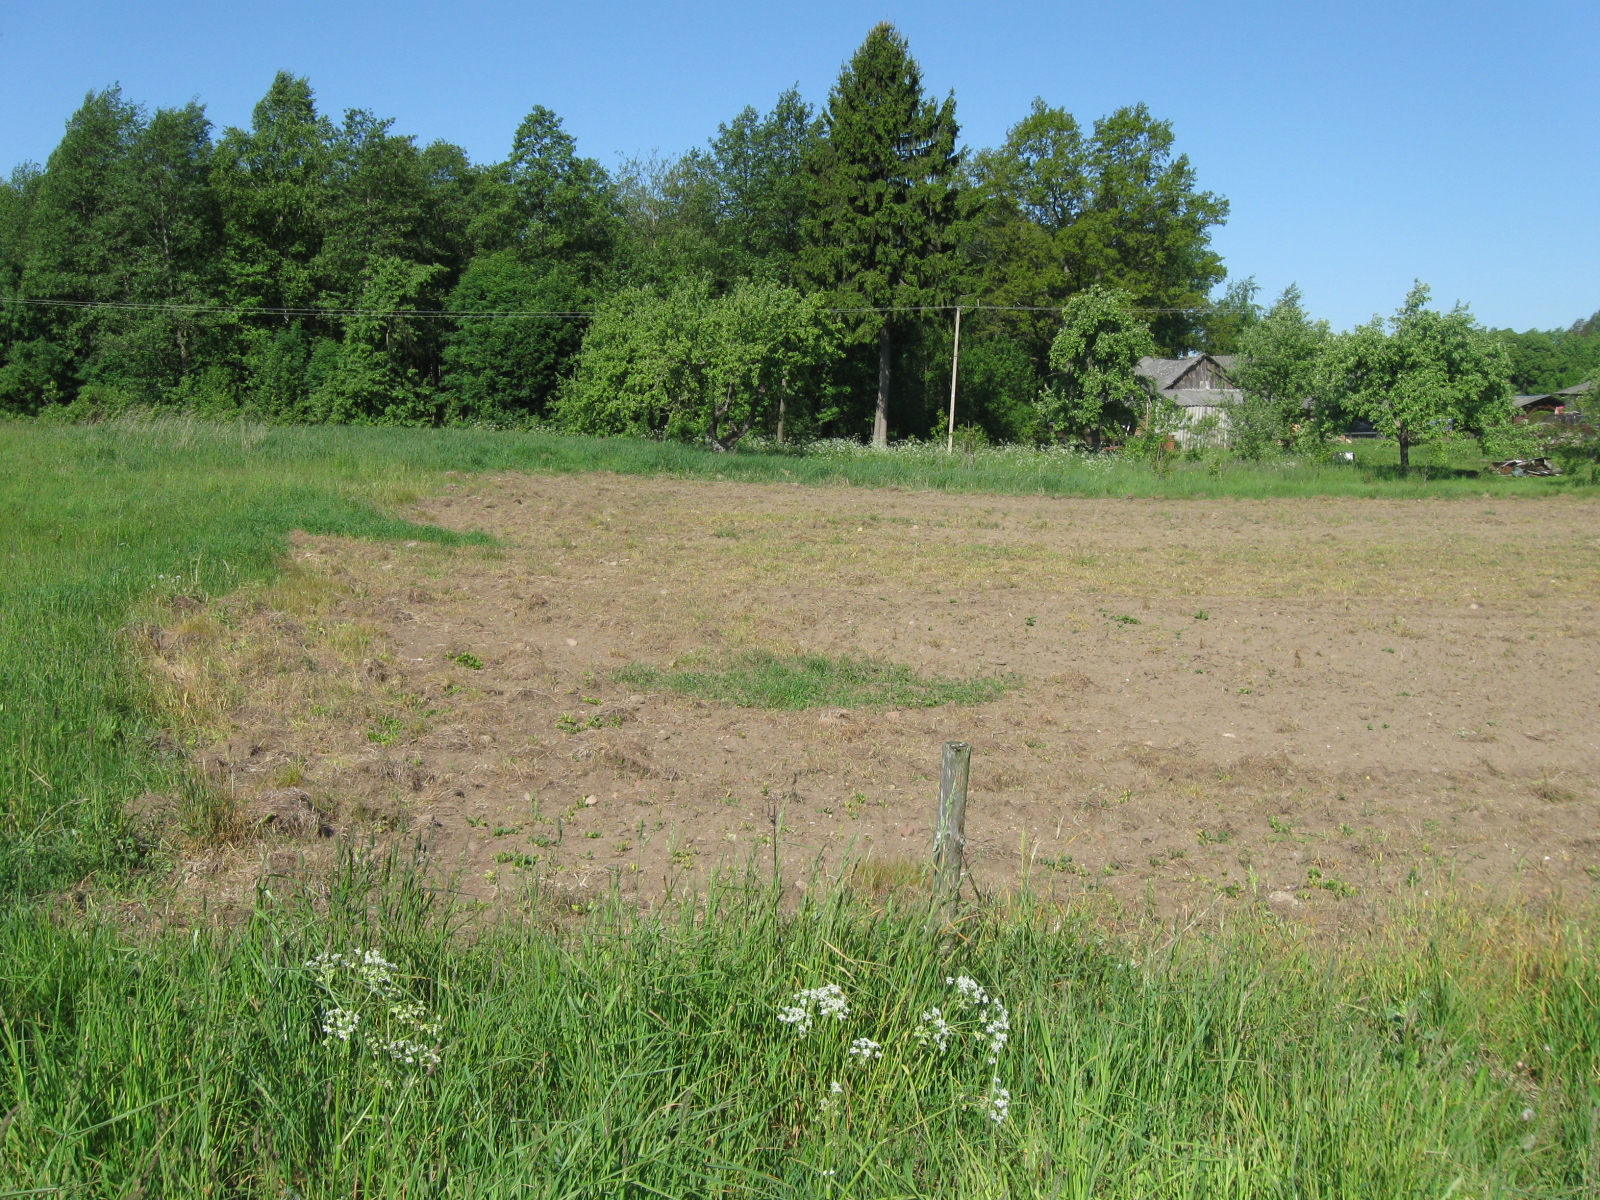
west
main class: Grassland
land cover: Grassland without tree/shrub cover
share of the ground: > 75 %
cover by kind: herbaceous plants 100 %
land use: Agriculture (excluding fallow land and kitchen gardens)
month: June
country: LT
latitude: 54.1753
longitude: 23.4874
